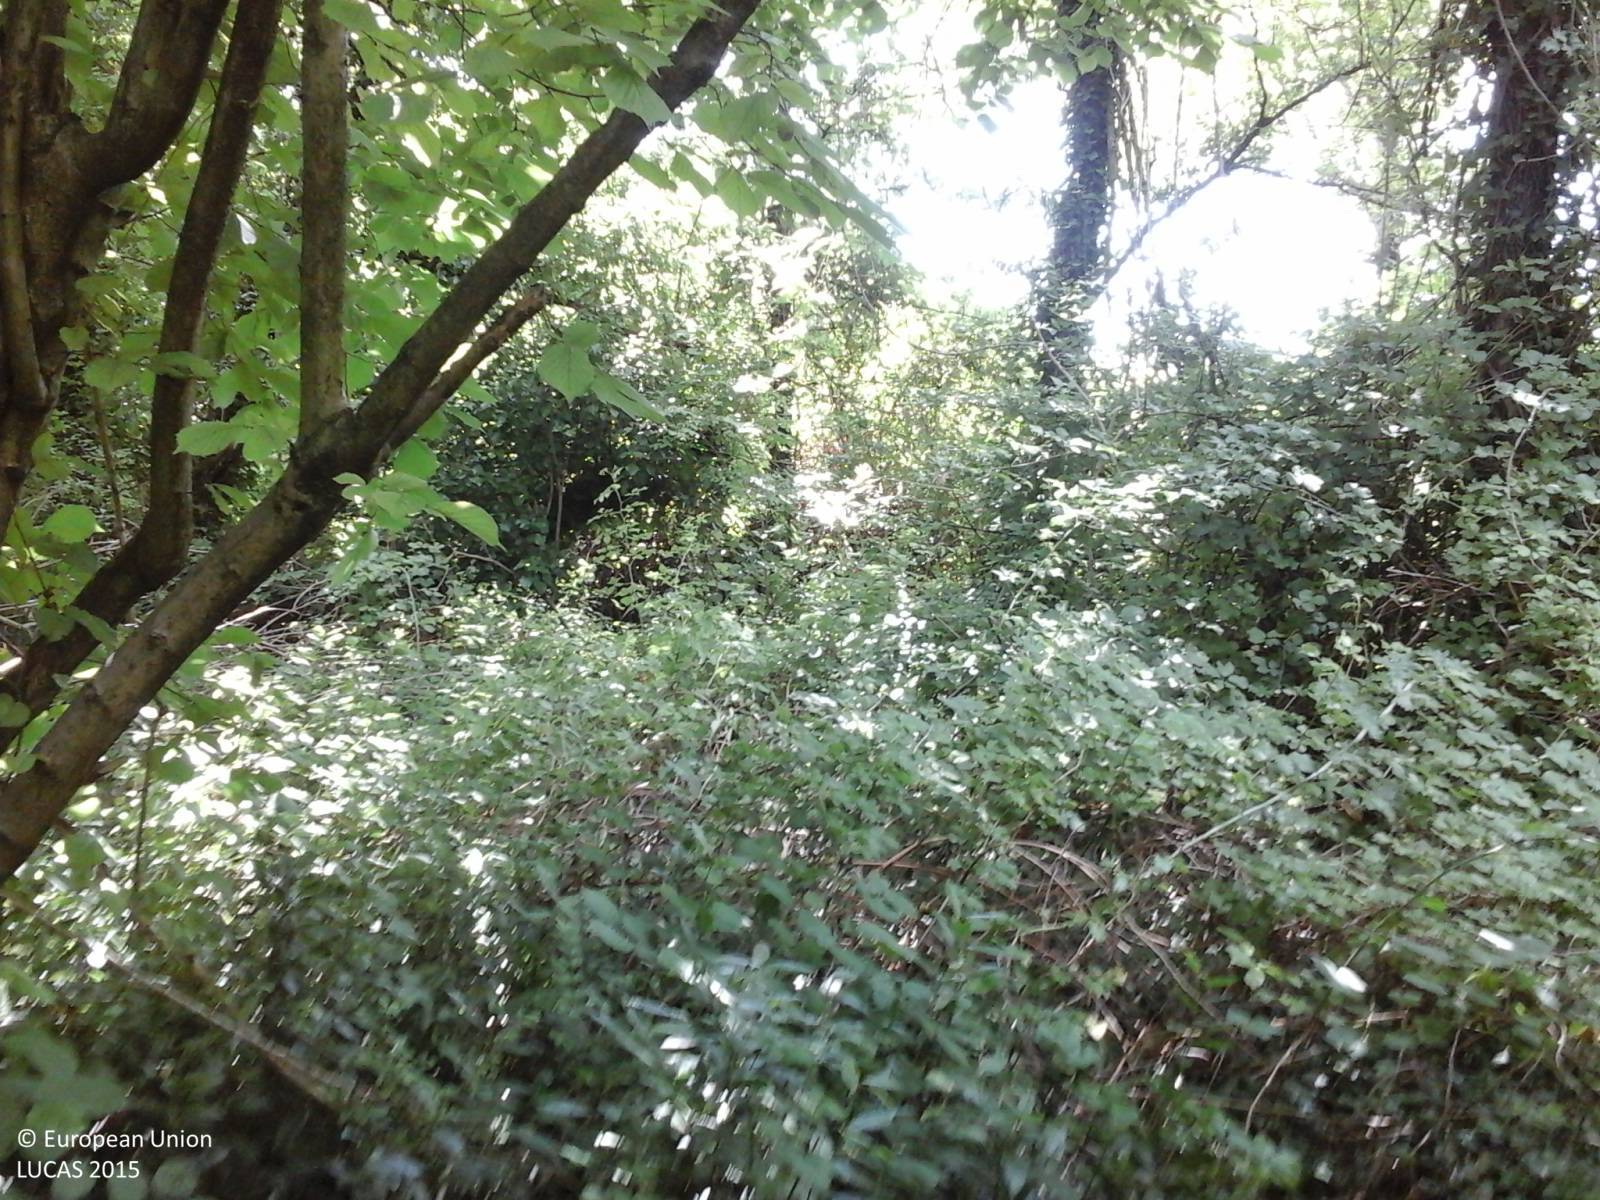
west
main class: Woodland
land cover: Broadleaved woodland
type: thermophilous deciduous forest
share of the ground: > 75 %
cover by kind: broadleaved forest trees 80 %, shrubs 20 %
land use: Semi-natural and natural areas not in use
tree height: > 5 m
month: June
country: IT
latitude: 45.7863
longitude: 13.5846
